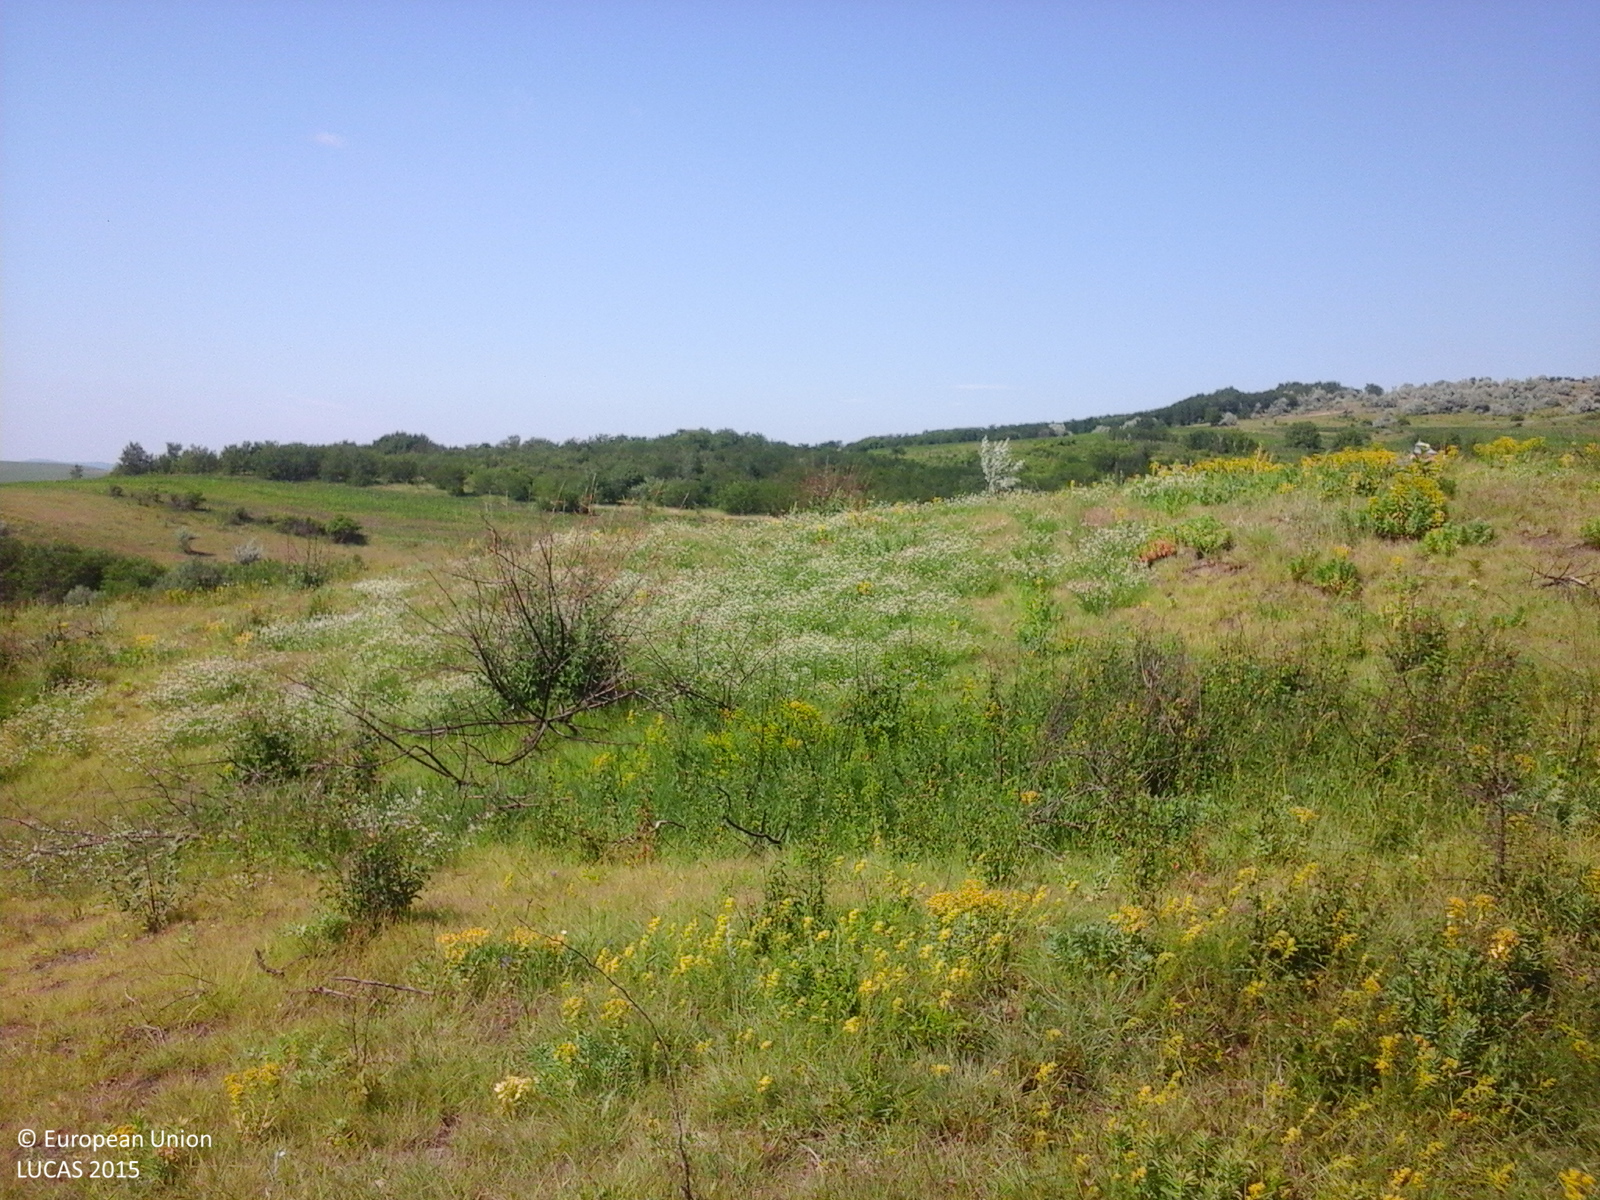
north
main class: Grassland
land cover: Grassland with sparse tree/shrub cover
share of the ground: 25 - 50 %
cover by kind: herbaceous plants 90 %, broadleaved forest trees 5 %, shrubs 5 %
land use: Agriculture (excluding fallow land and kitchen gardens)
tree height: < 5 m
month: June
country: RO
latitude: 46.7489
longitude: 27.9692
